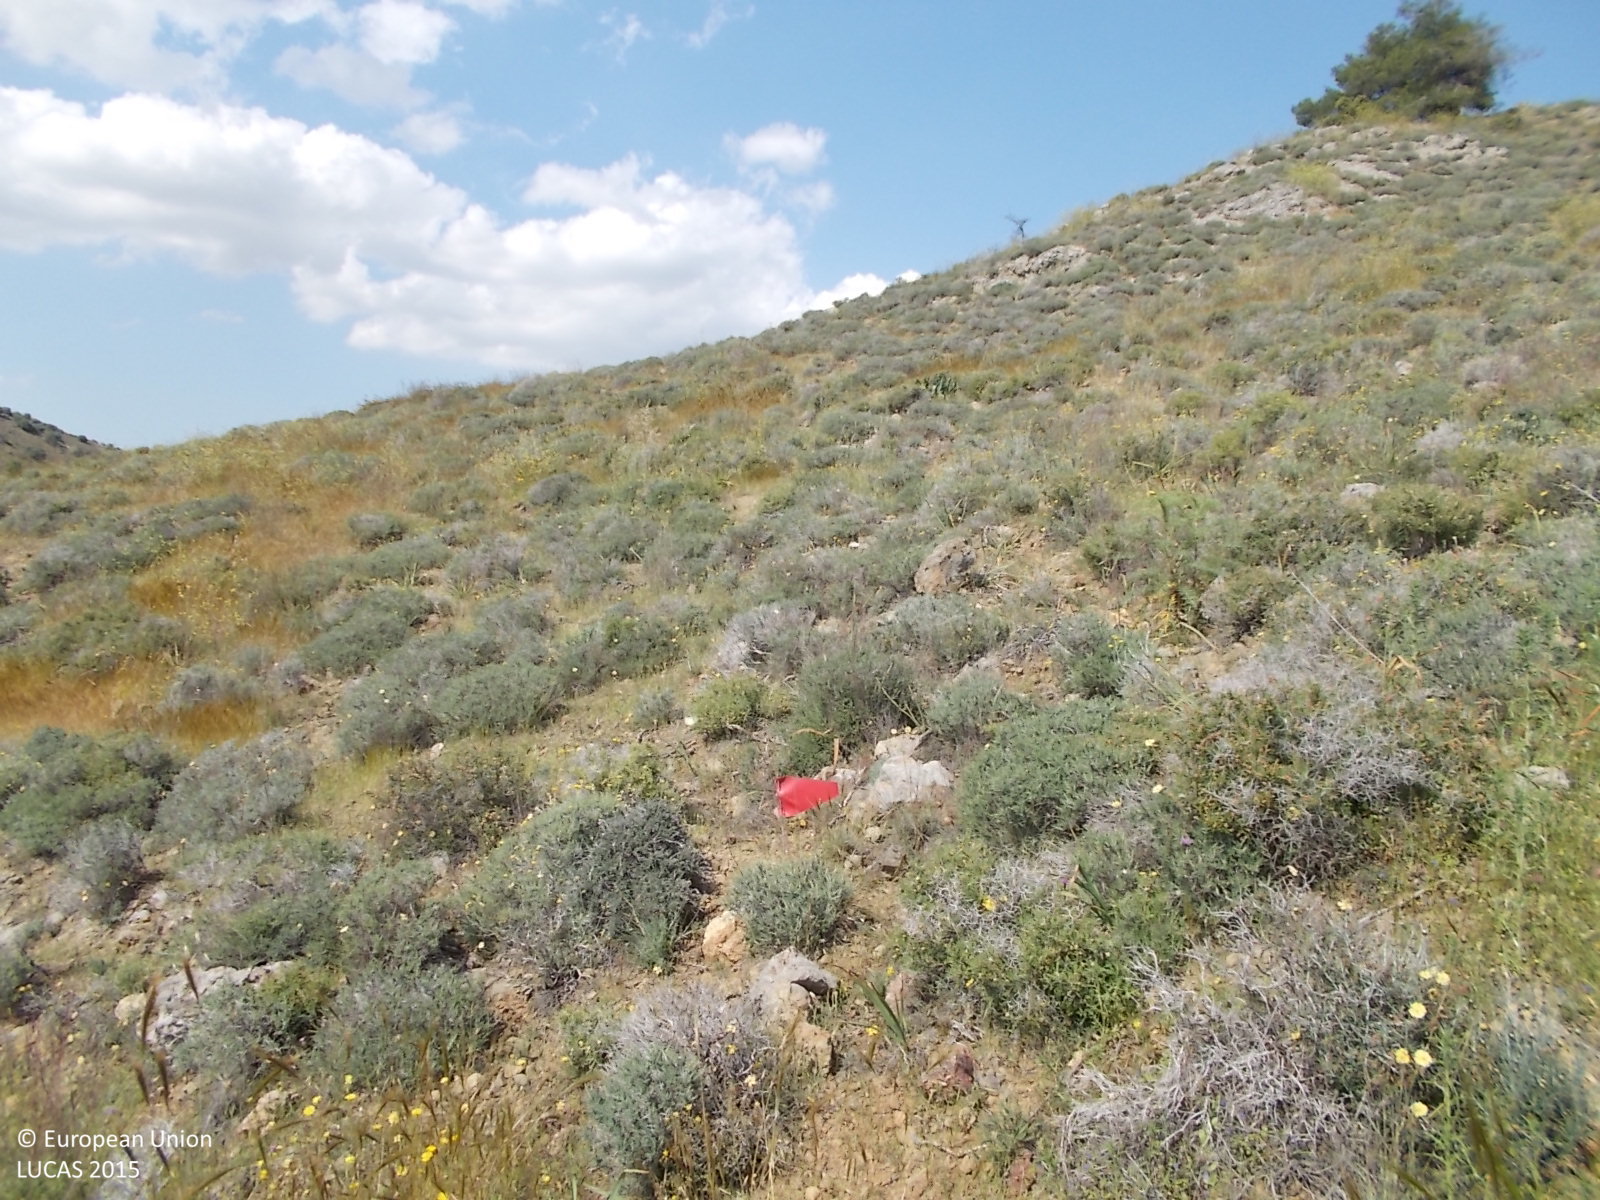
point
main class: Shrubland
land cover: Shrubland without tree cover
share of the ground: > 75 %
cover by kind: shrubs 75 %, herbaceous plants 15 %, unconsolidated bare surface 10 %
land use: Semi-natural and natural areas not in use
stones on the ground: 25 - 50 %
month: April
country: CY
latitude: 34.9562
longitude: 33.4616
